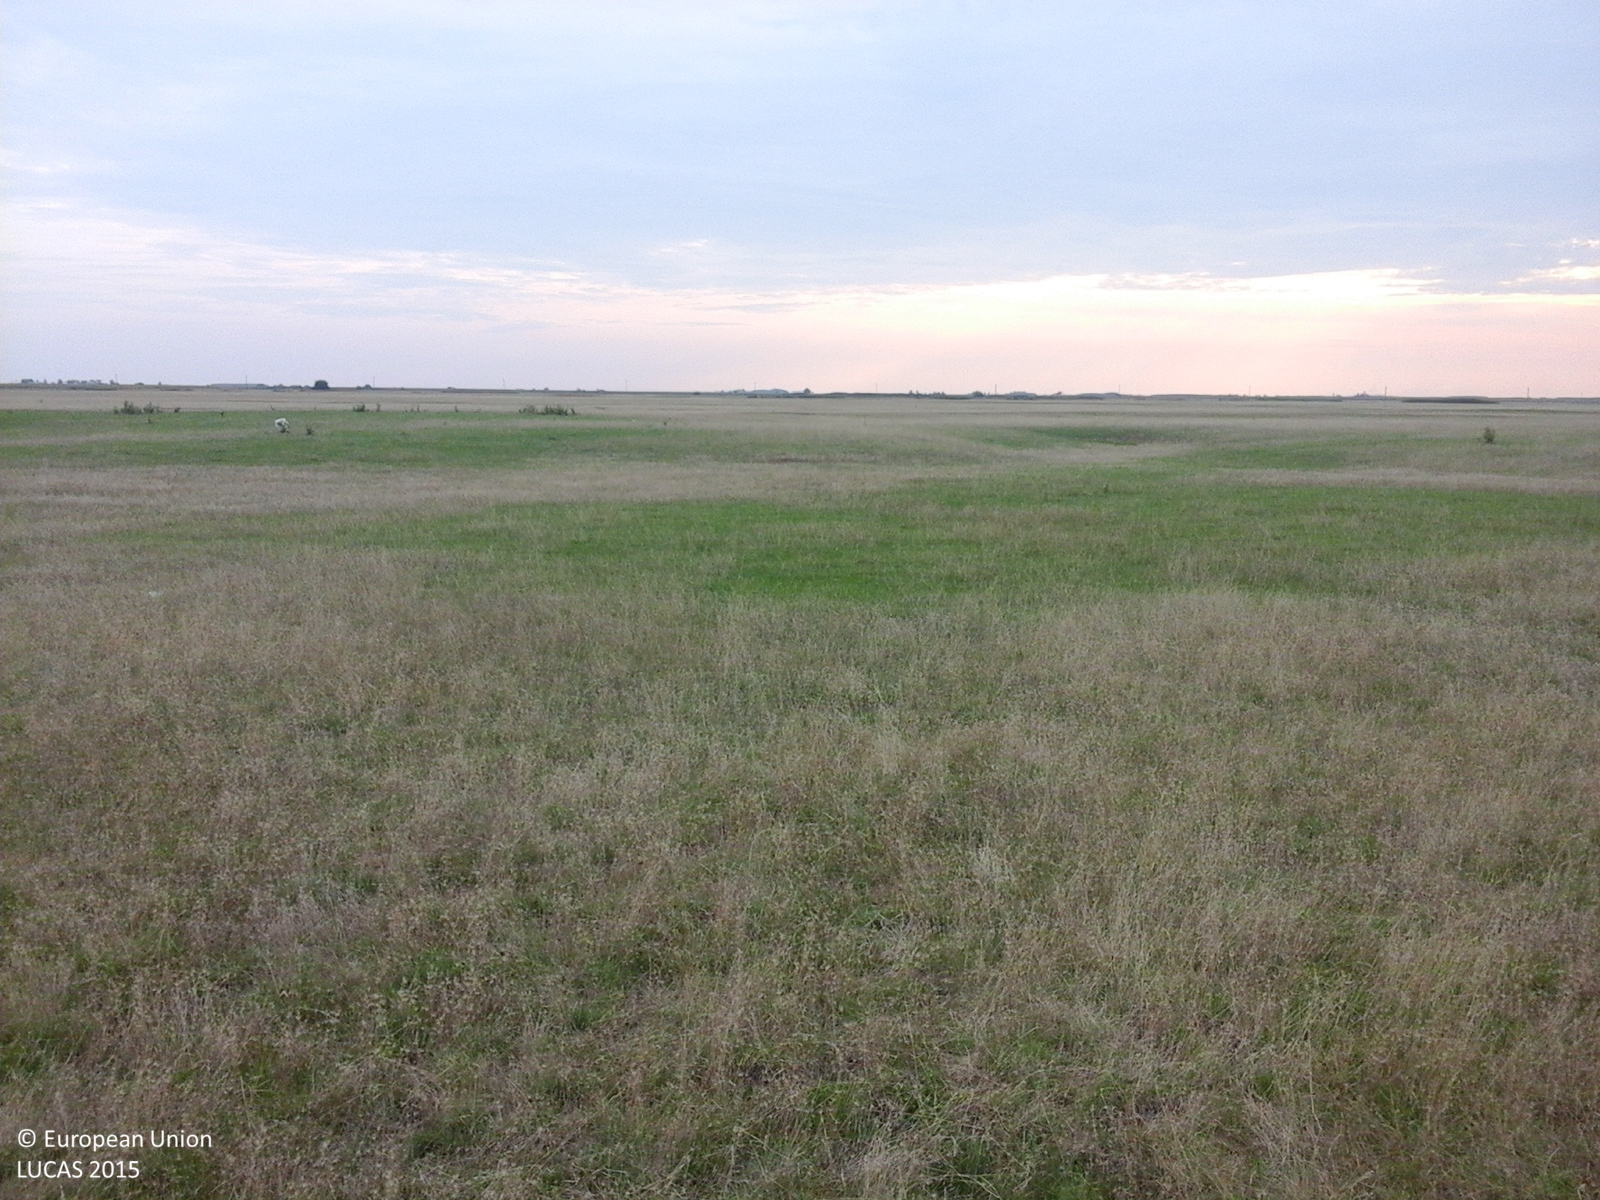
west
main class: Grassland
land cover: Grassland without tree/shrub cover
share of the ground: > 75 %
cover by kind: herbaceous plants 100 %
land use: Agriculture (excluding fallow land and kitchen gardens)
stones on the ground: < 10 %
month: August
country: RO
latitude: 46.3405
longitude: 21.2200
